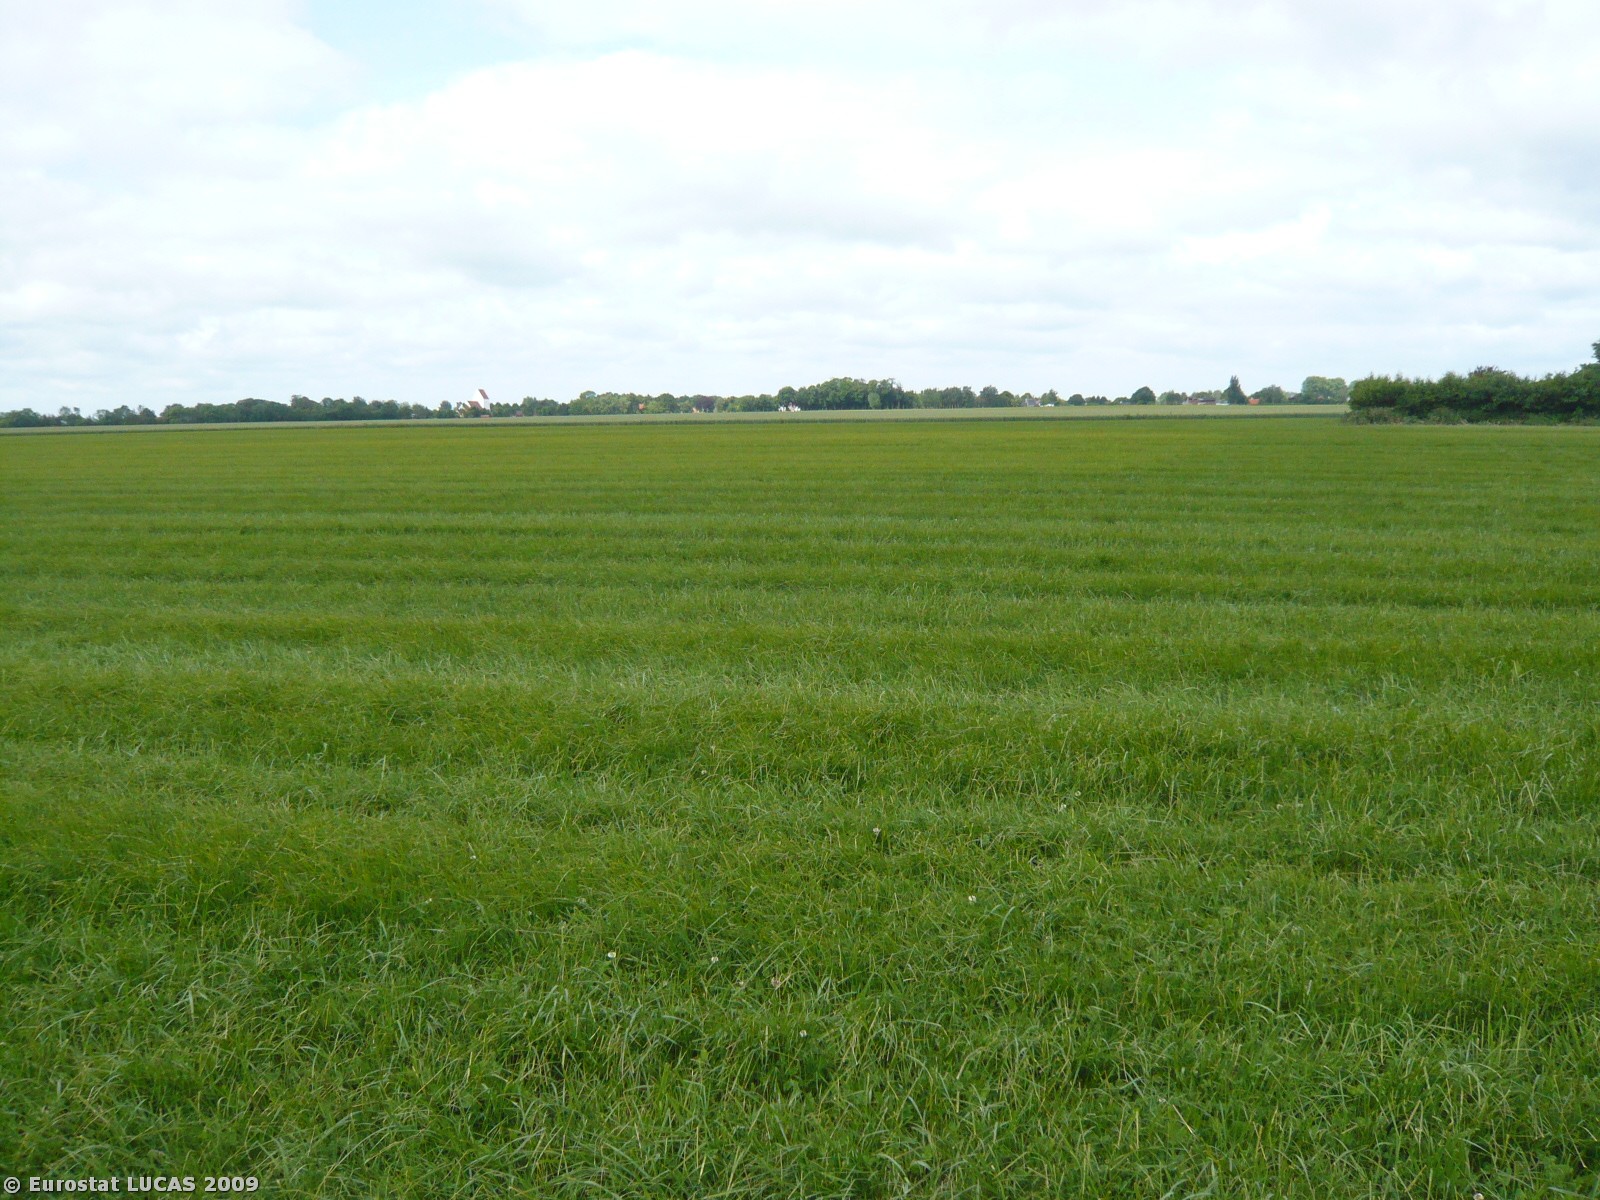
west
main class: Cropland
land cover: Common wheat
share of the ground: > 75 %
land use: Agriculture (excluding fallow land and kitchen gardens)
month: June
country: DK
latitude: 54.9238
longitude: 11.2006
